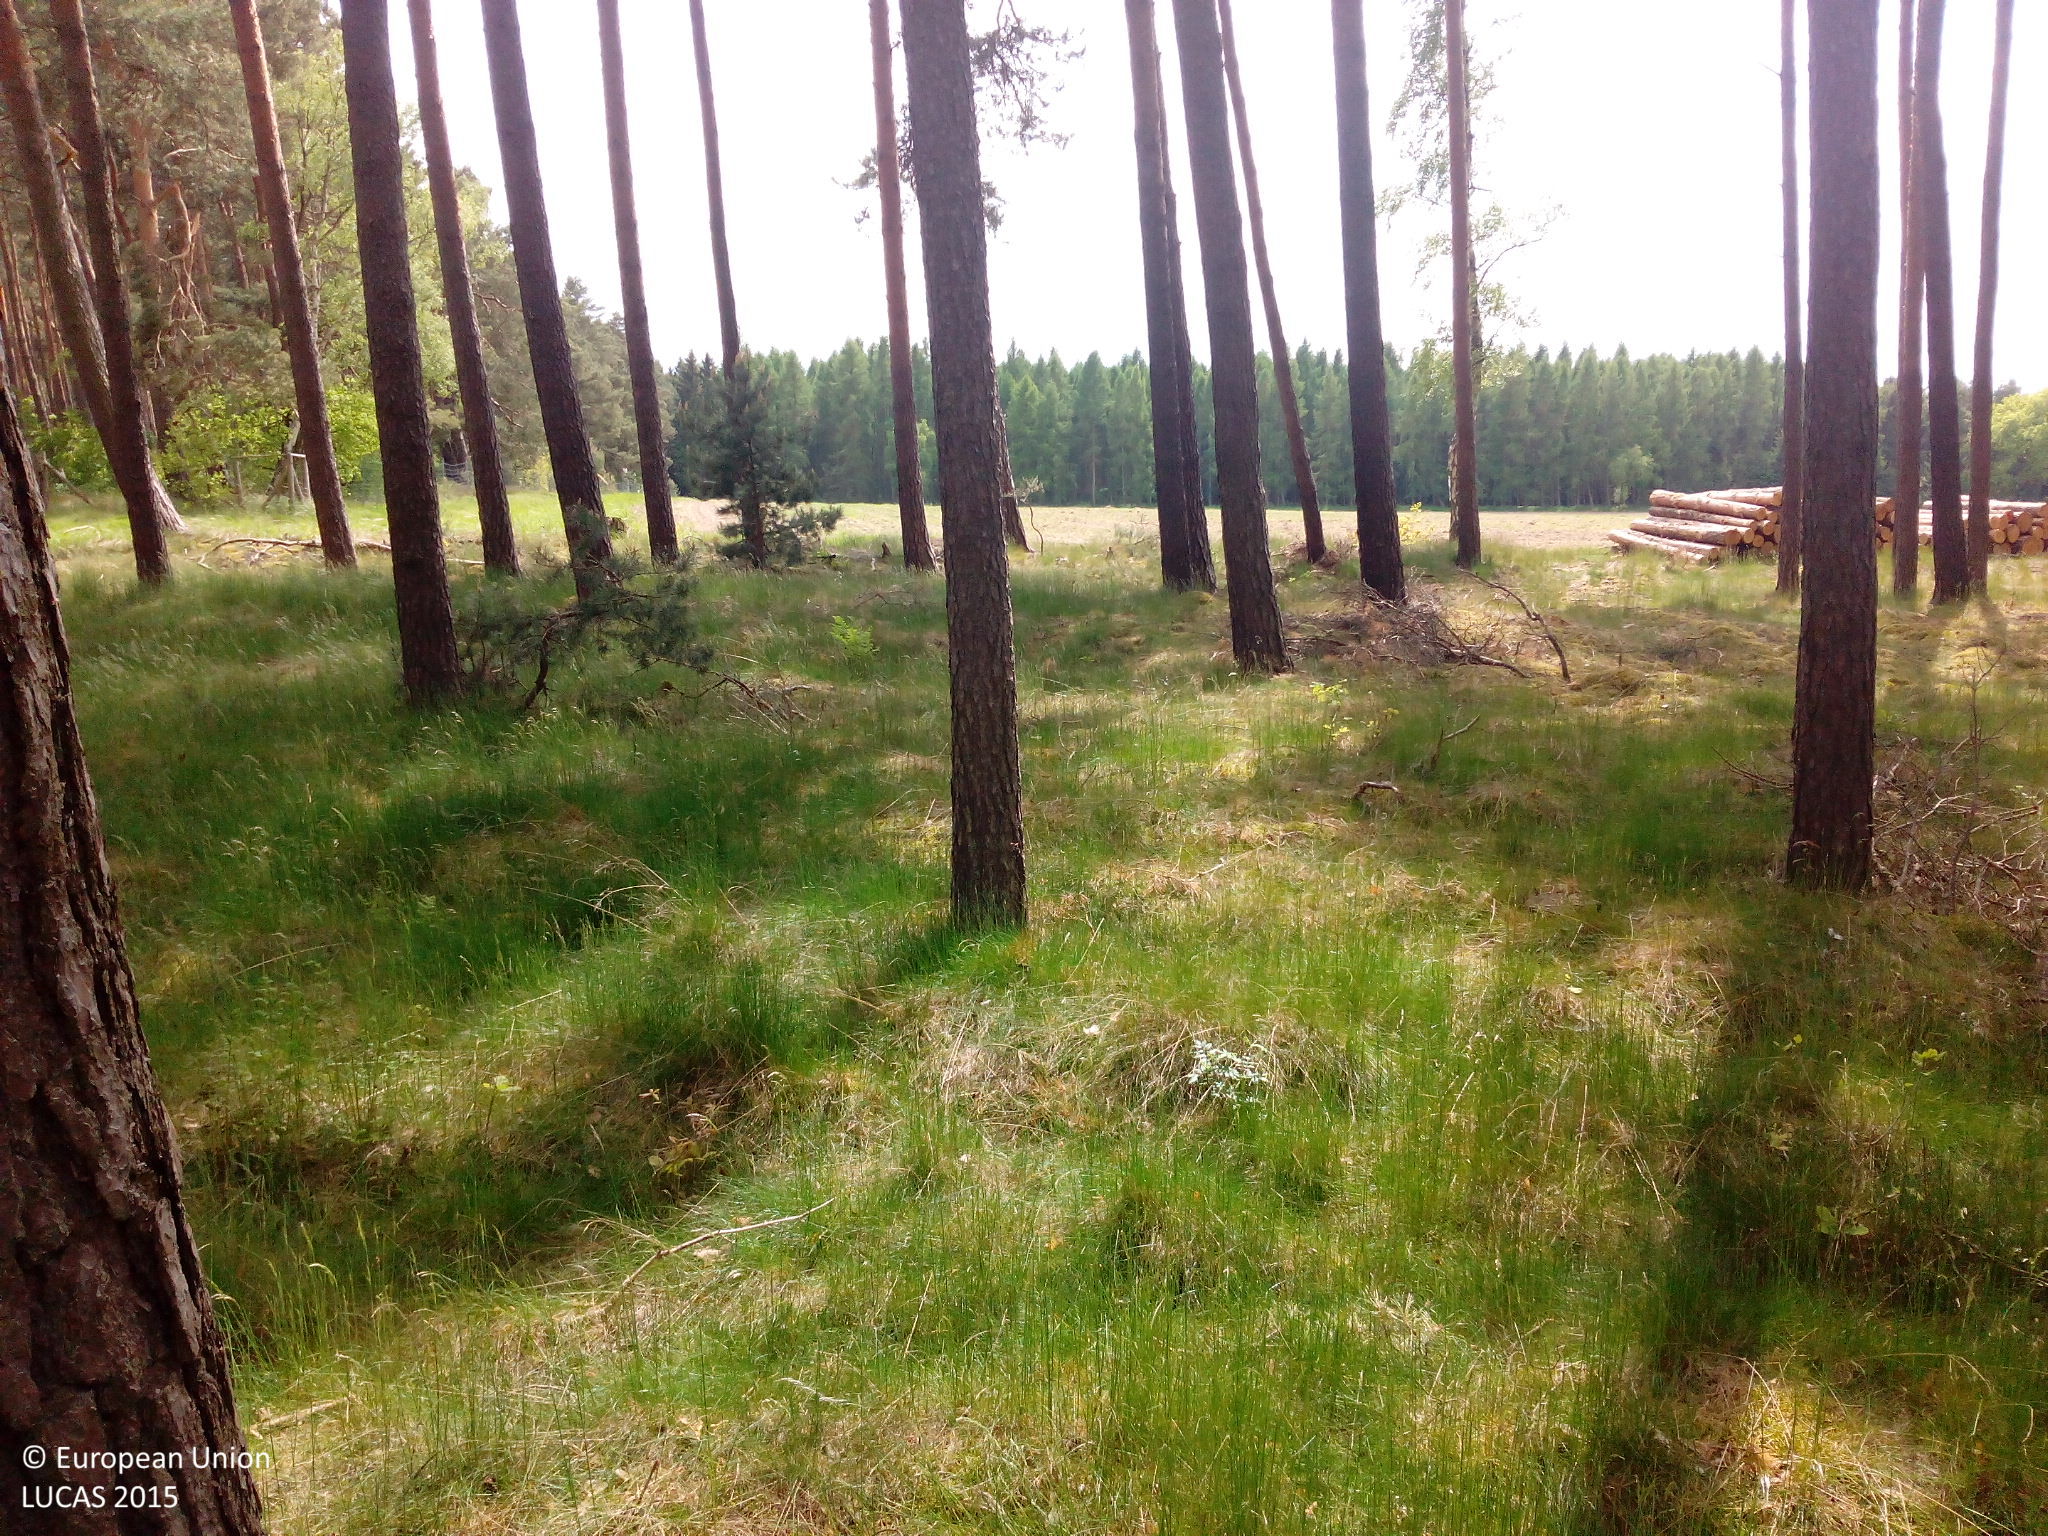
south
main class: Woodland
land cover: Pine dominated coniferous woodland
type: hemiboreal forest and nemoral coniferous forest and mixed broadleaved-coniferous forest
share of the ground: 50 - 75 %
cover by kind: coniferous forest trees 60 %, herbaceous plants 30 %, shrubs 10 %
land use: Forestry
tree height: > 5 m
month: May
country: DE
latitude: 52.6596
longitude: 11.1380
